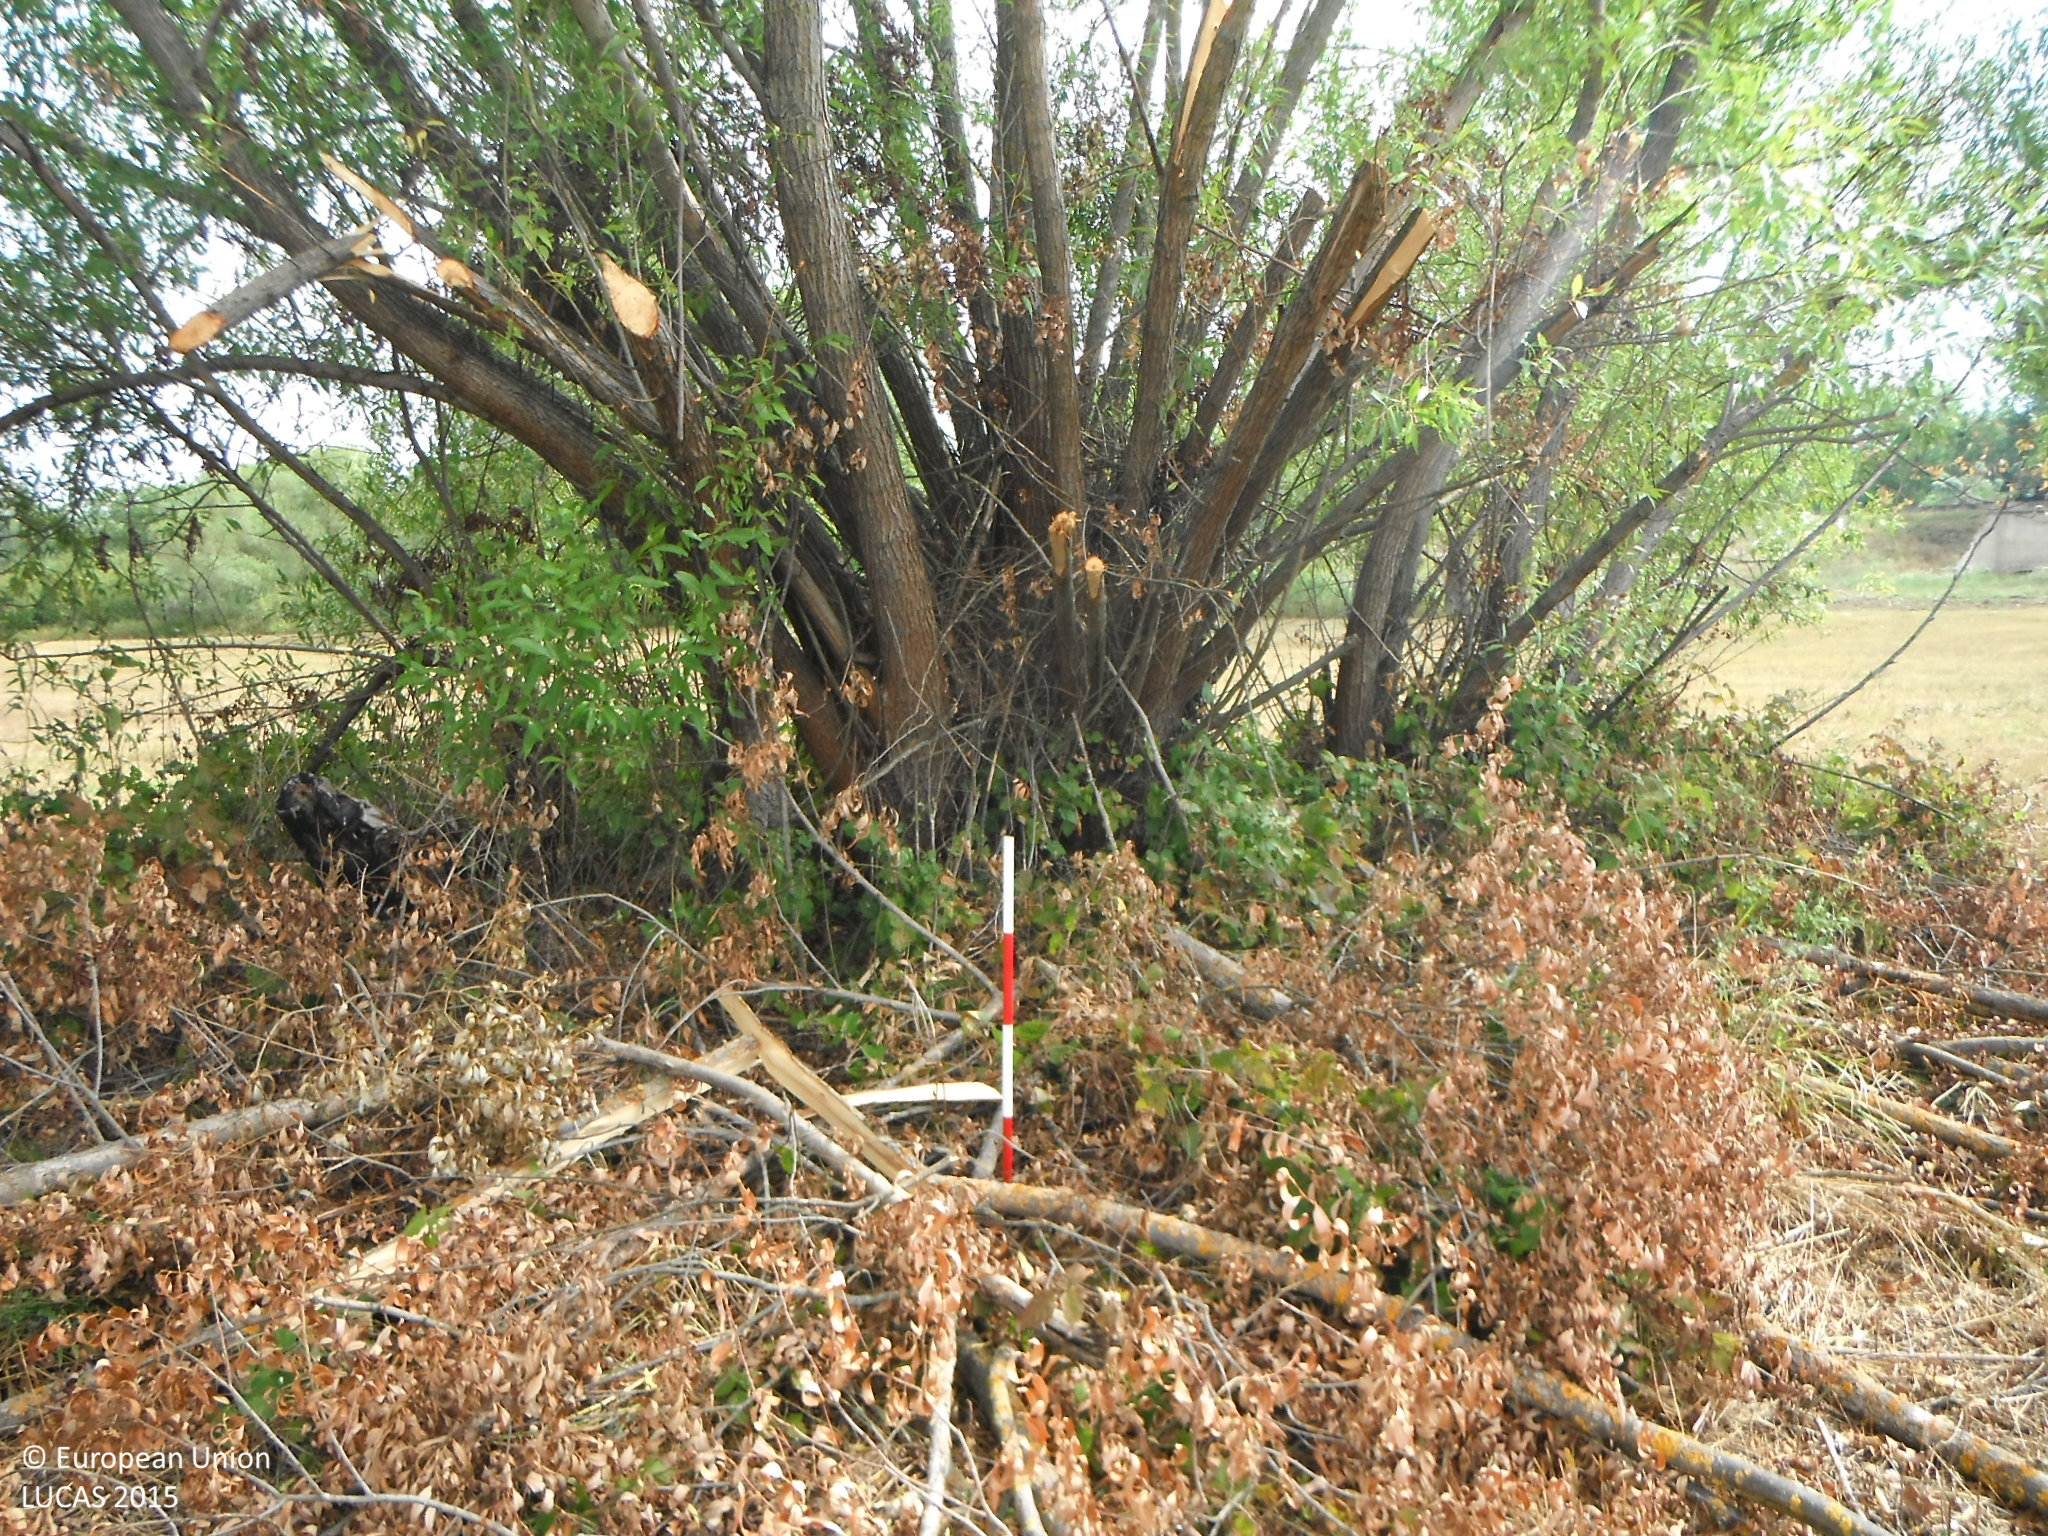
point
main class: Grassland
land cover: Grassland with sparse tree/shrub cover
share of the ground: > 75 %
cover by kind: herbaceous plants 90 %, broadleaved forest trees 5 %, shrubs 5 %
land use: Agriculture (excluding fallow land and kitchen gardens)
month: August
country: SK
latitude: 48.4924
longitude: 21.8378
